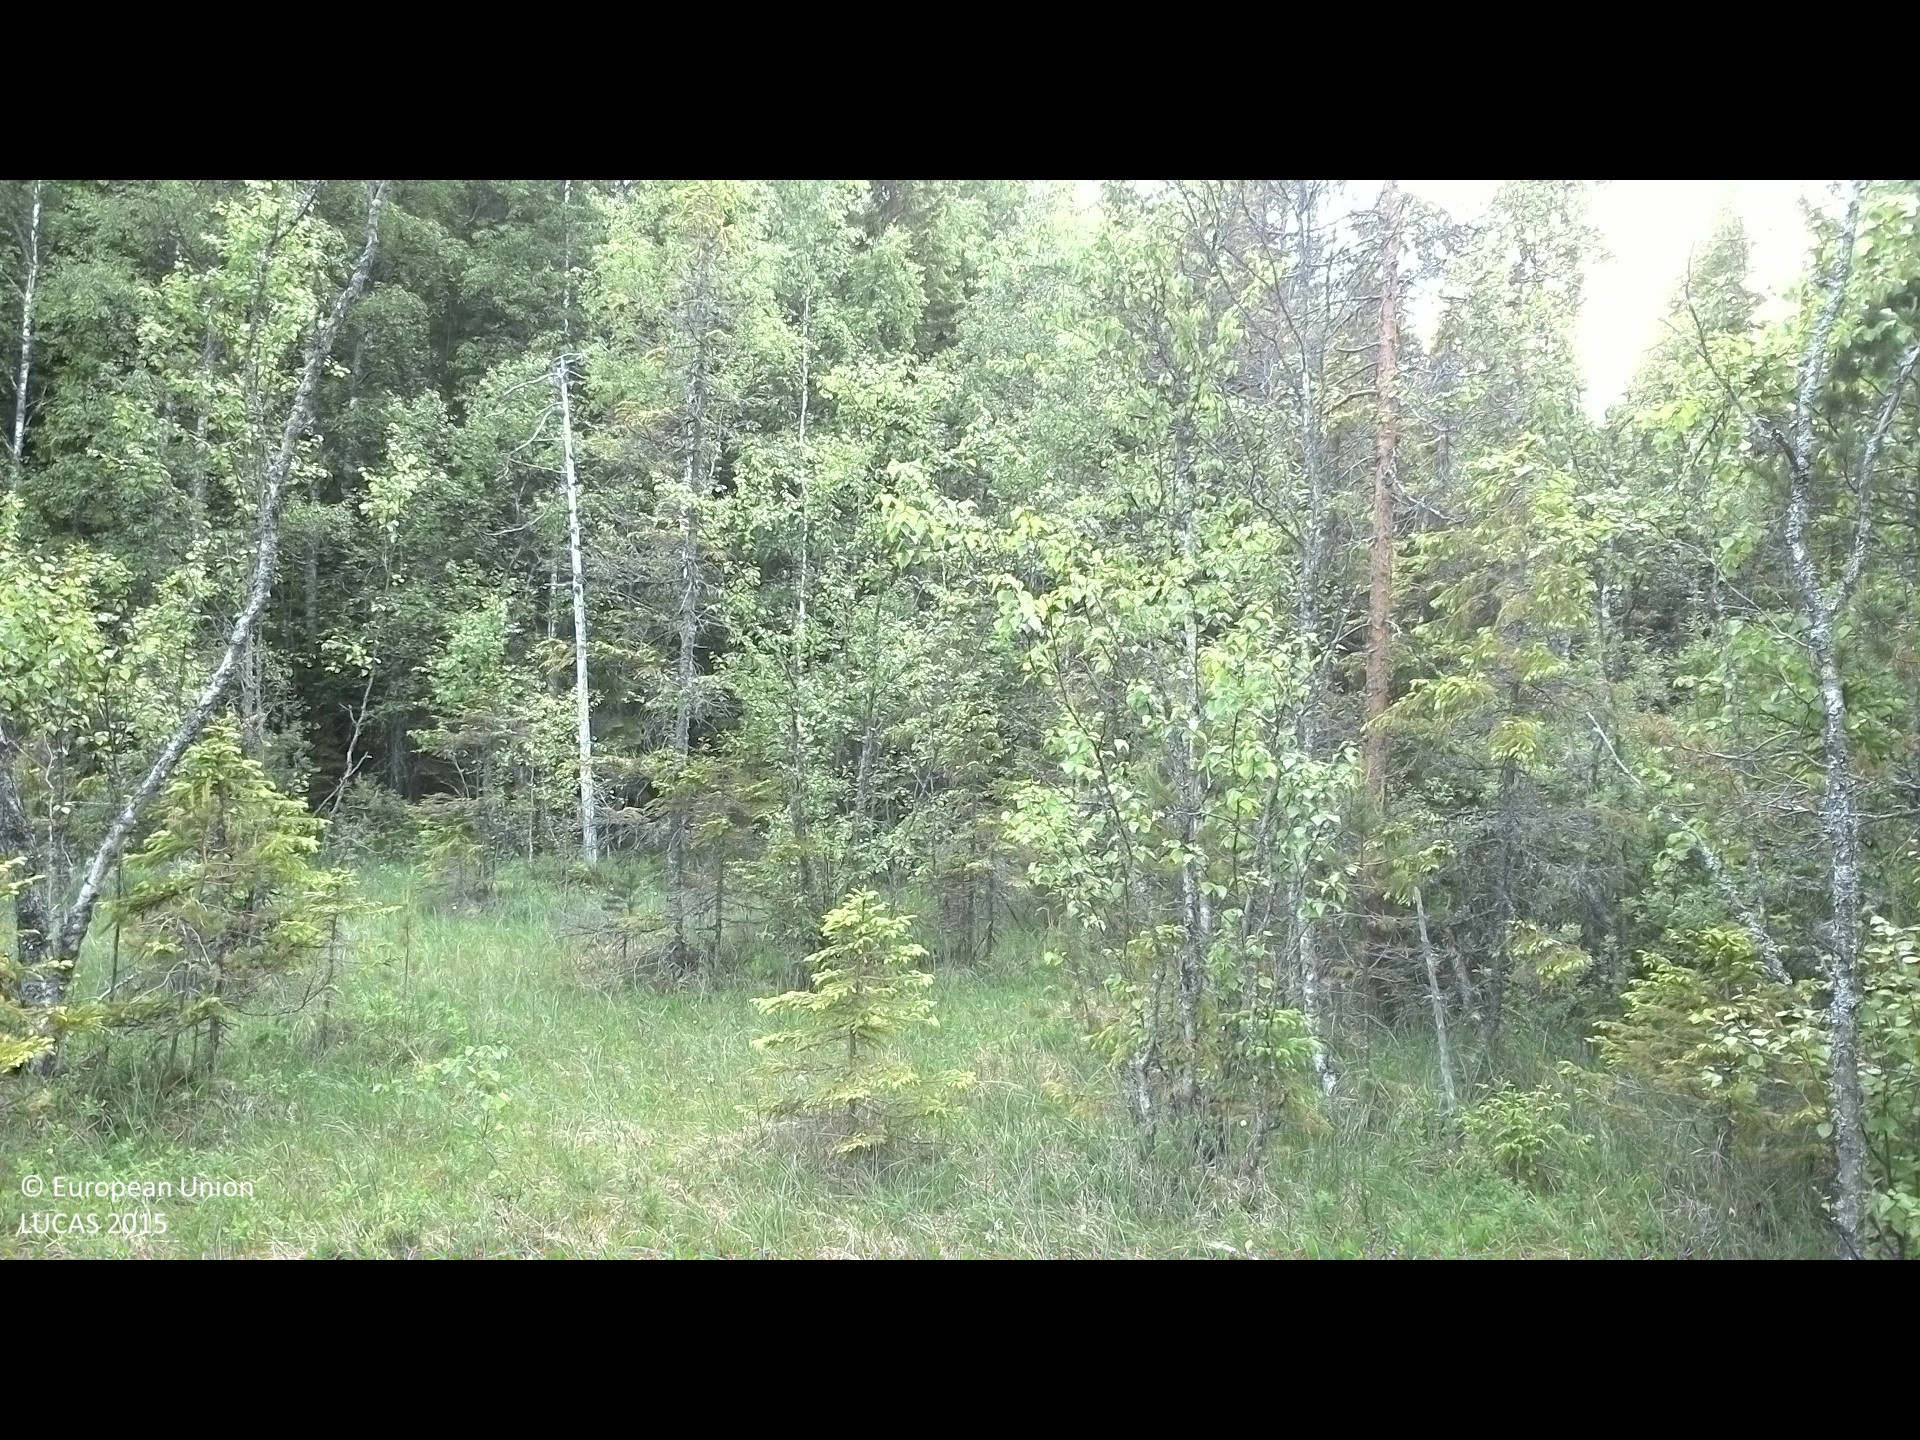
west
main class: Woodland
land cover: Pine dominated coniferous woodland
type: boreal forest
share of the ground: 50 - 75 %
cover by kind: lichens and mosses 55 %, coniferous forest trees 40 %, broadleaved forest trees 5 %
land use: Semi-natural and natural areas not in use
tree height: > 5 m
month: June
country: SE
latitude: 61.9507
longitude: 16.8258
